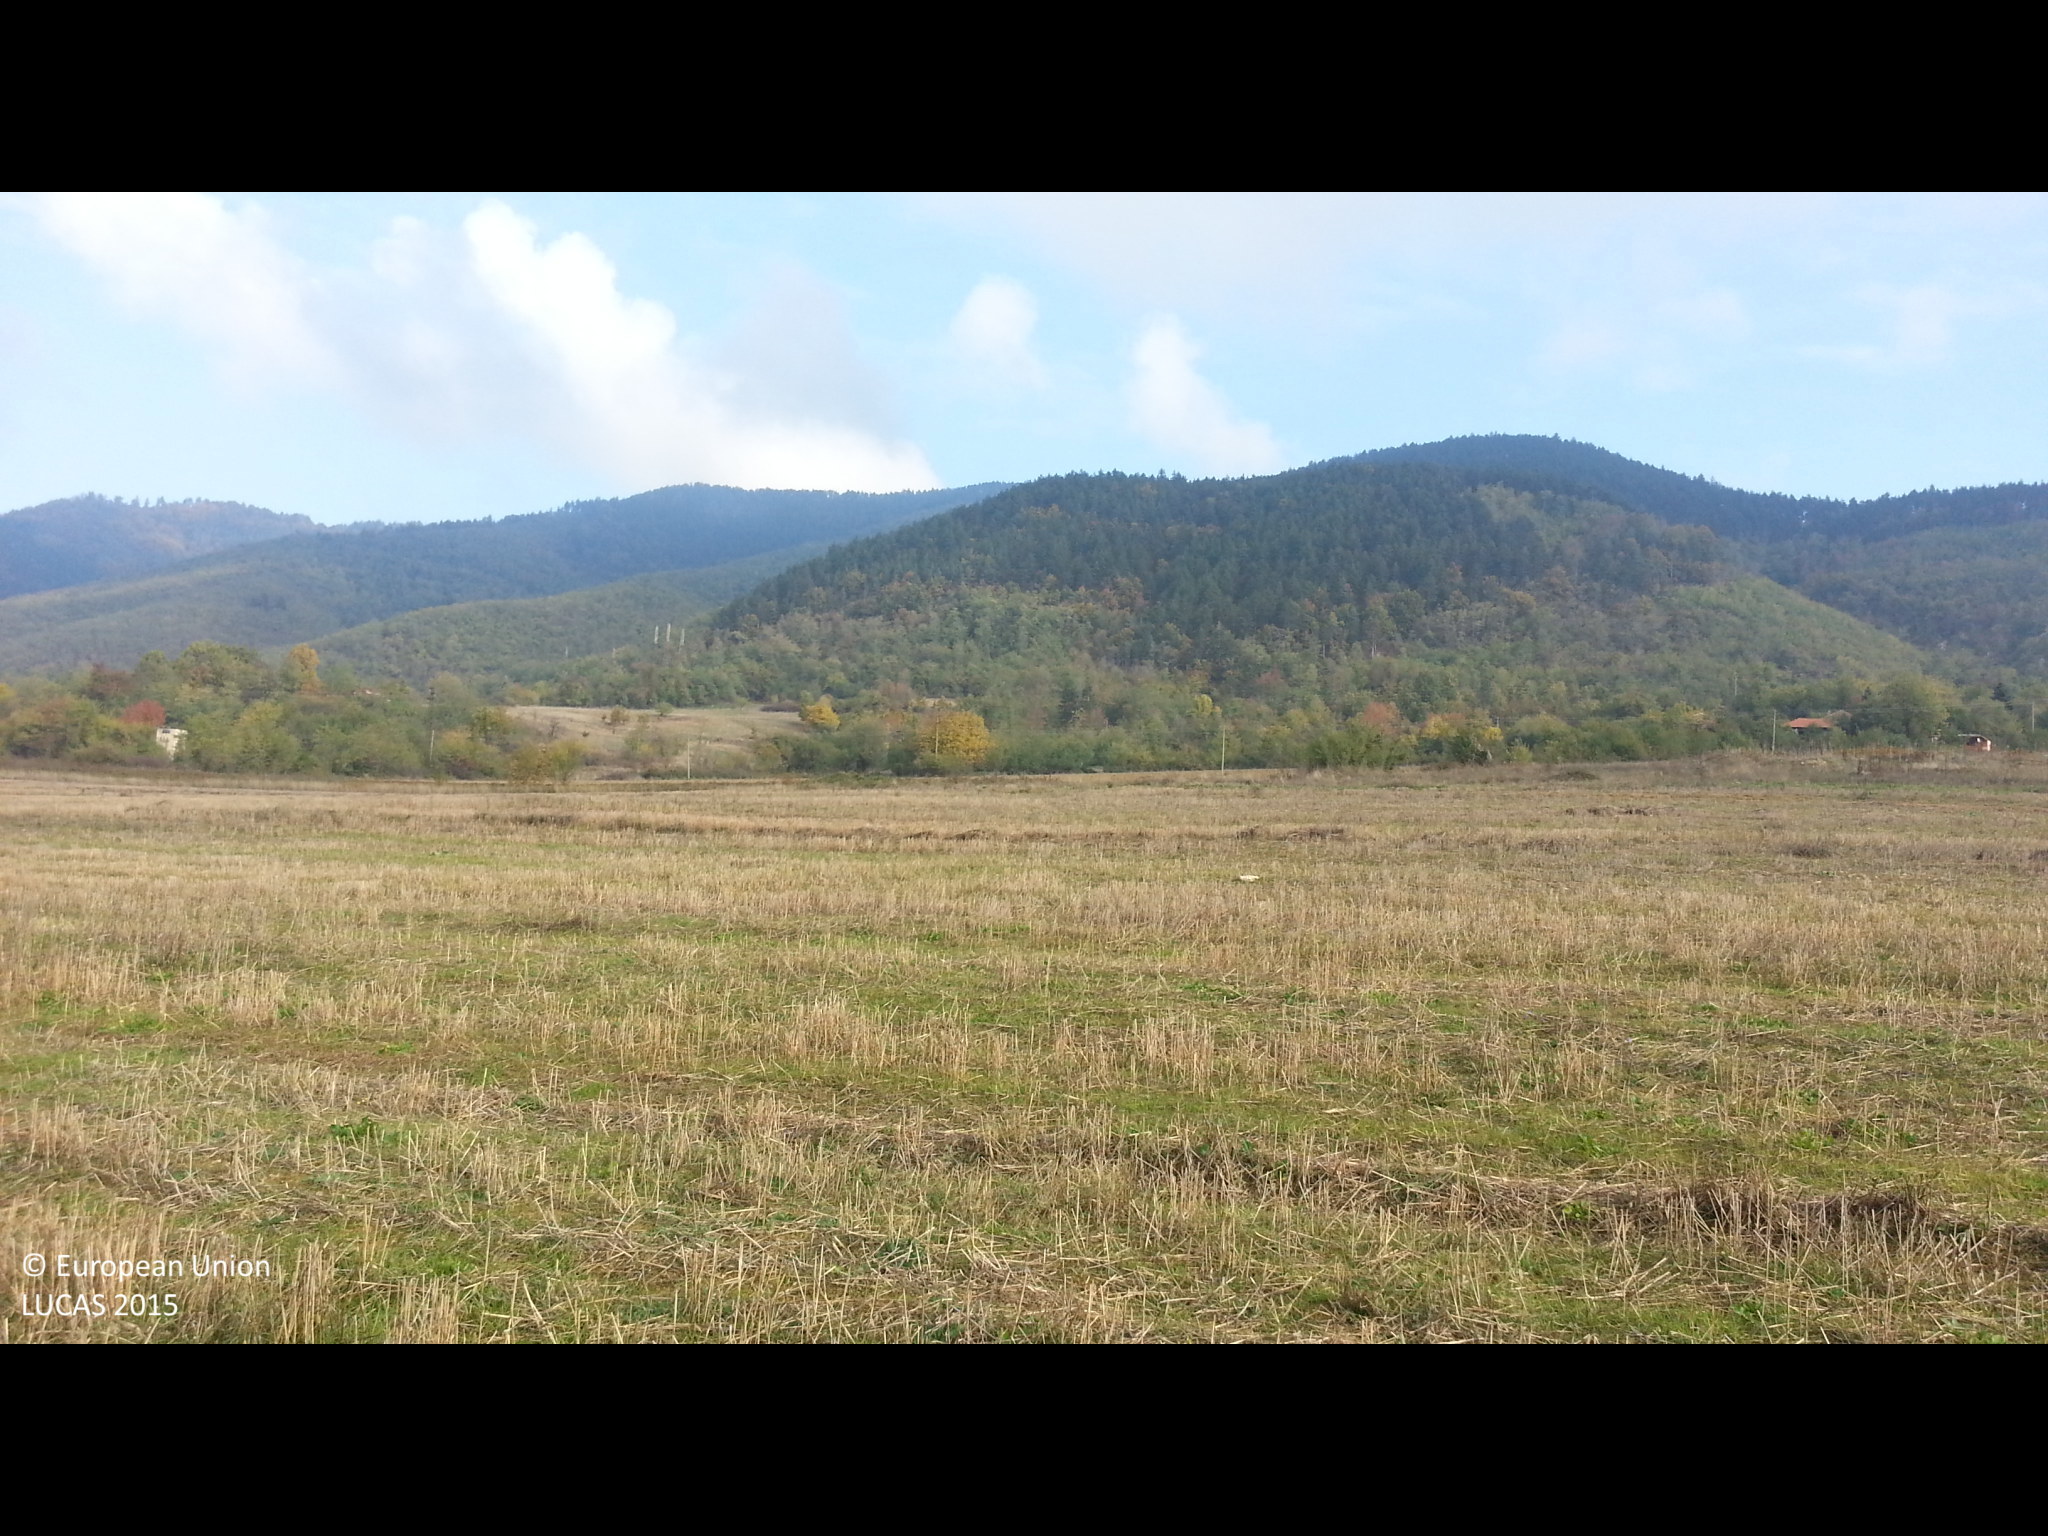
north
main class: Cropland
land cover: Common wheat
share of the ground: 10 - 25 %
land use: Agriculture (excluding fallow land and kitchen gardens)
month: November
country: BG
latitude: 42.9194
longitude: 23.8760
